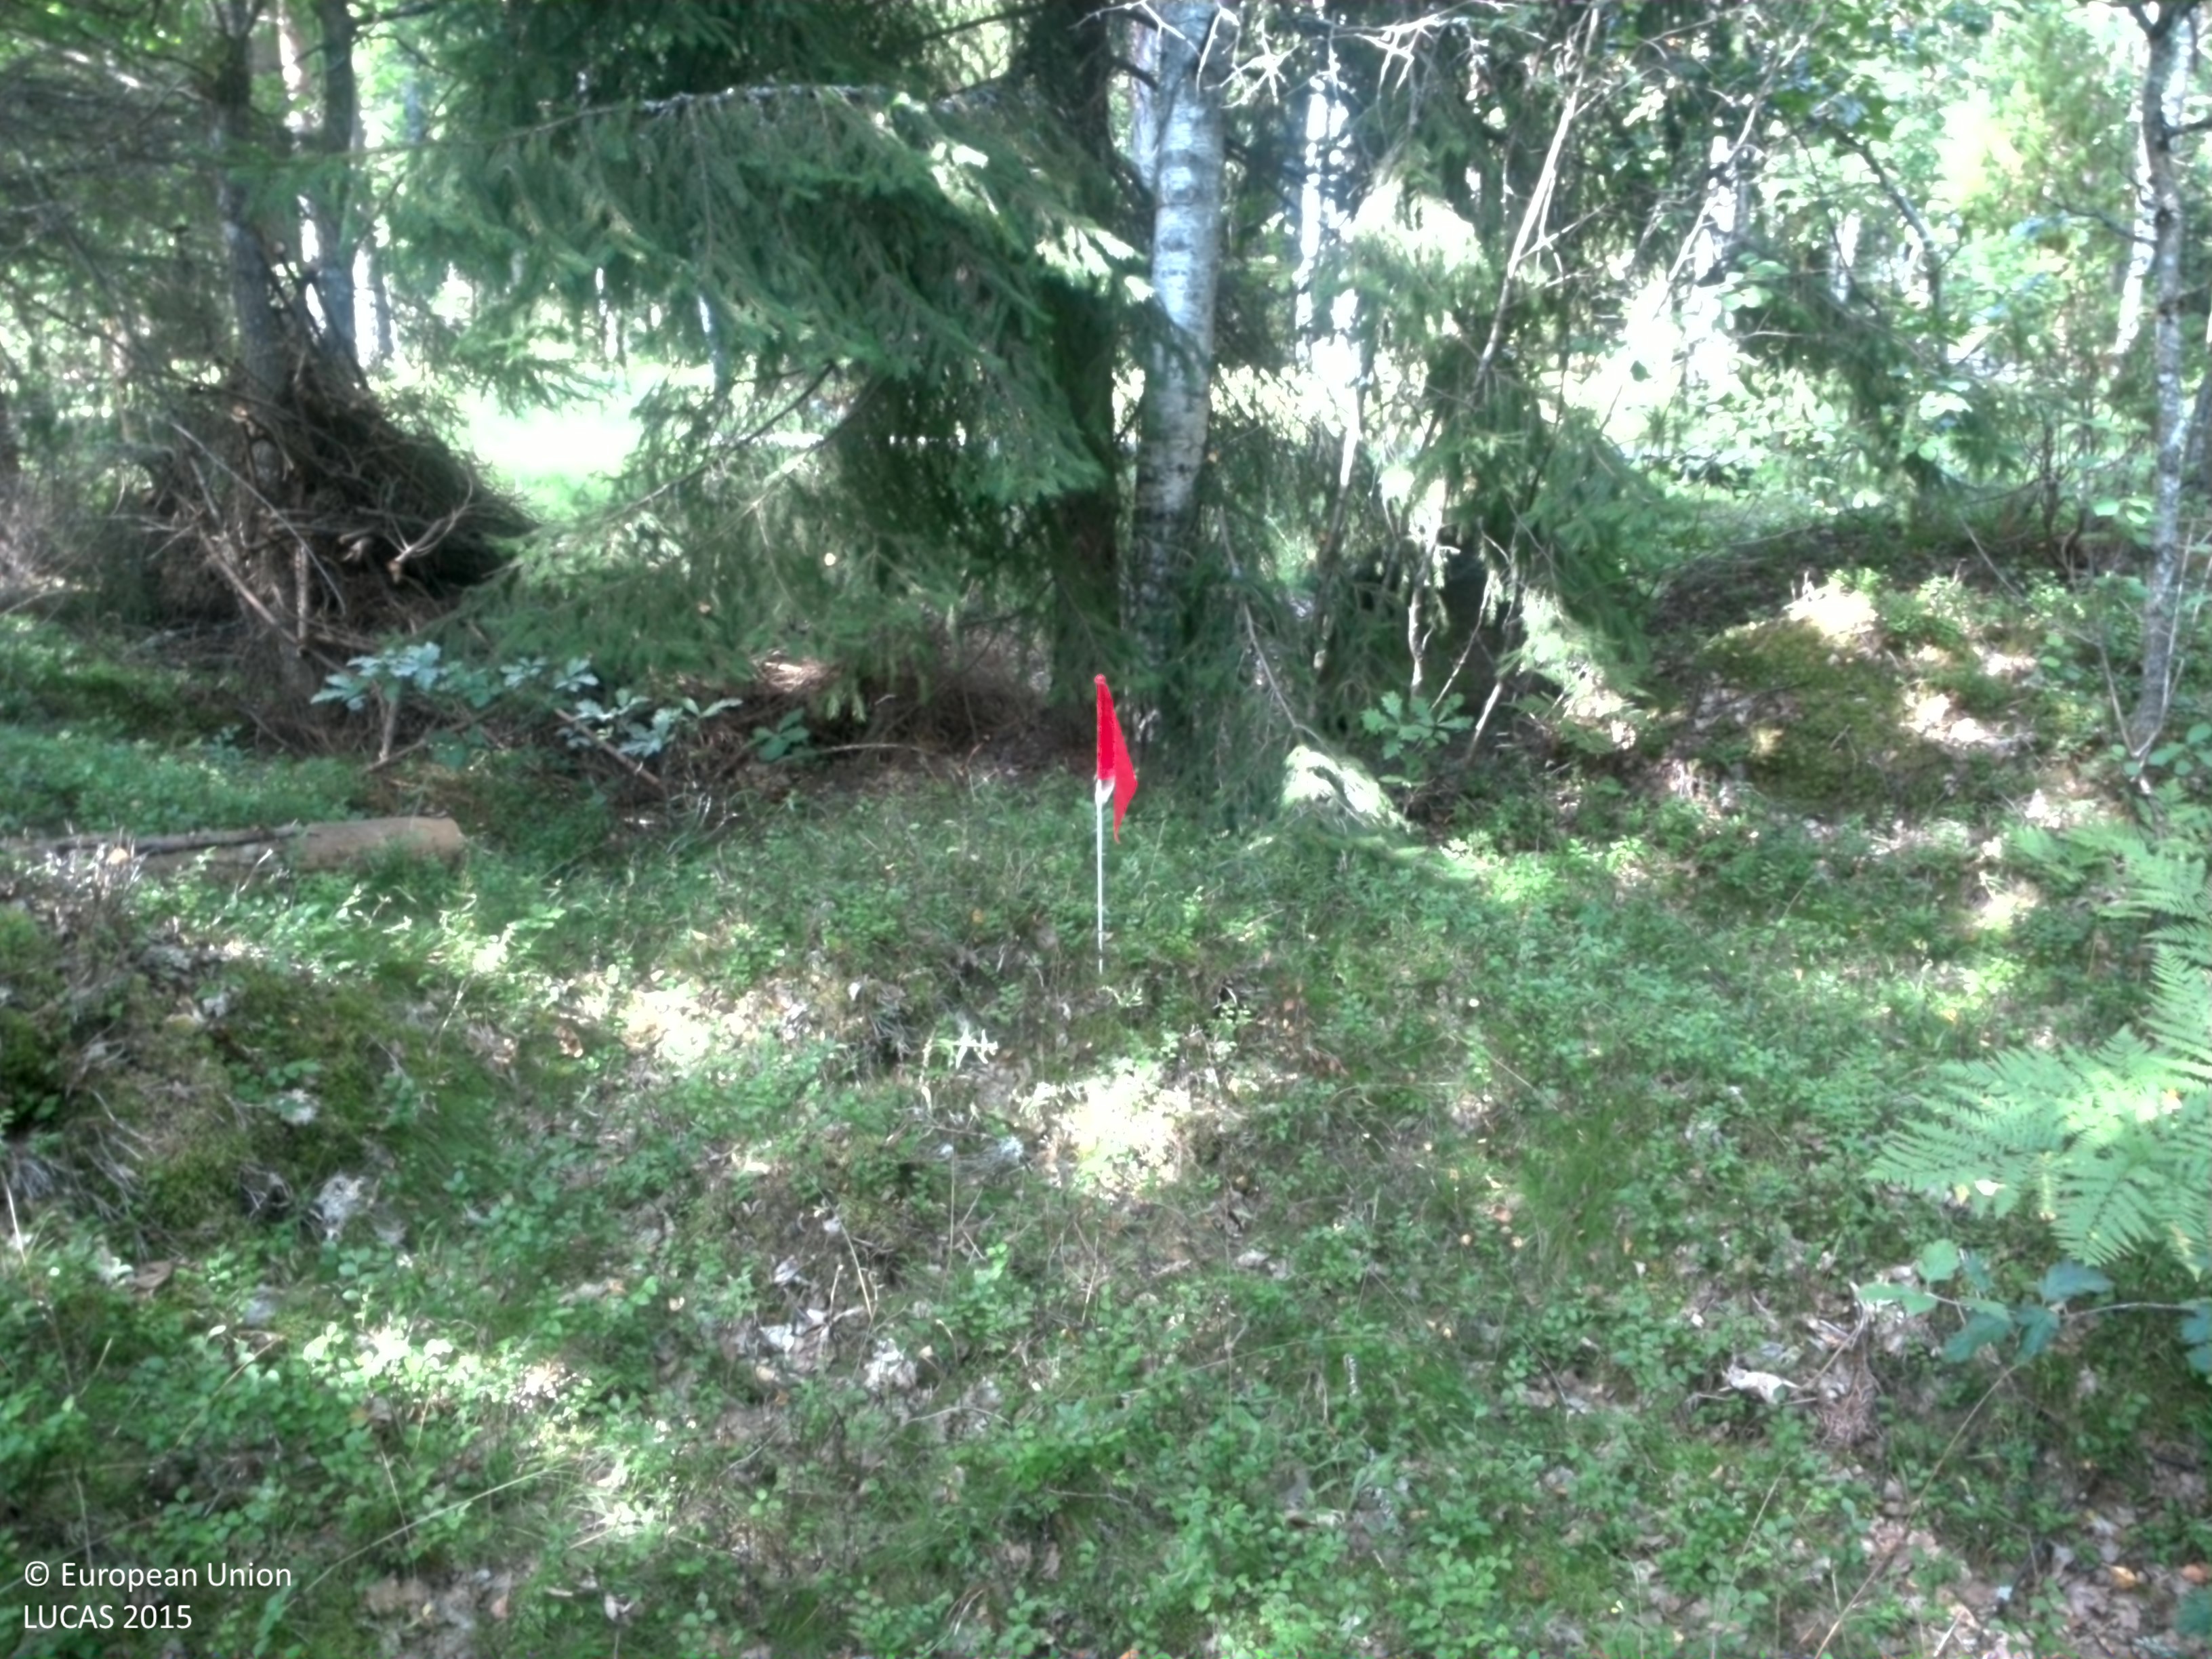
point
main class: Woodland
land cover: Other mixed woodland
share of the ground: 50 - 75 %
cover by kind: broadleaved forest trees 35 %, coniferous forest trees 25 %, shrubs 15 %, herbaceous plants 15 %, lichens and mosses 10 %
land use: Forestry
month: August
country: SE
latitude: 58.1445
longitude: 13.2393
